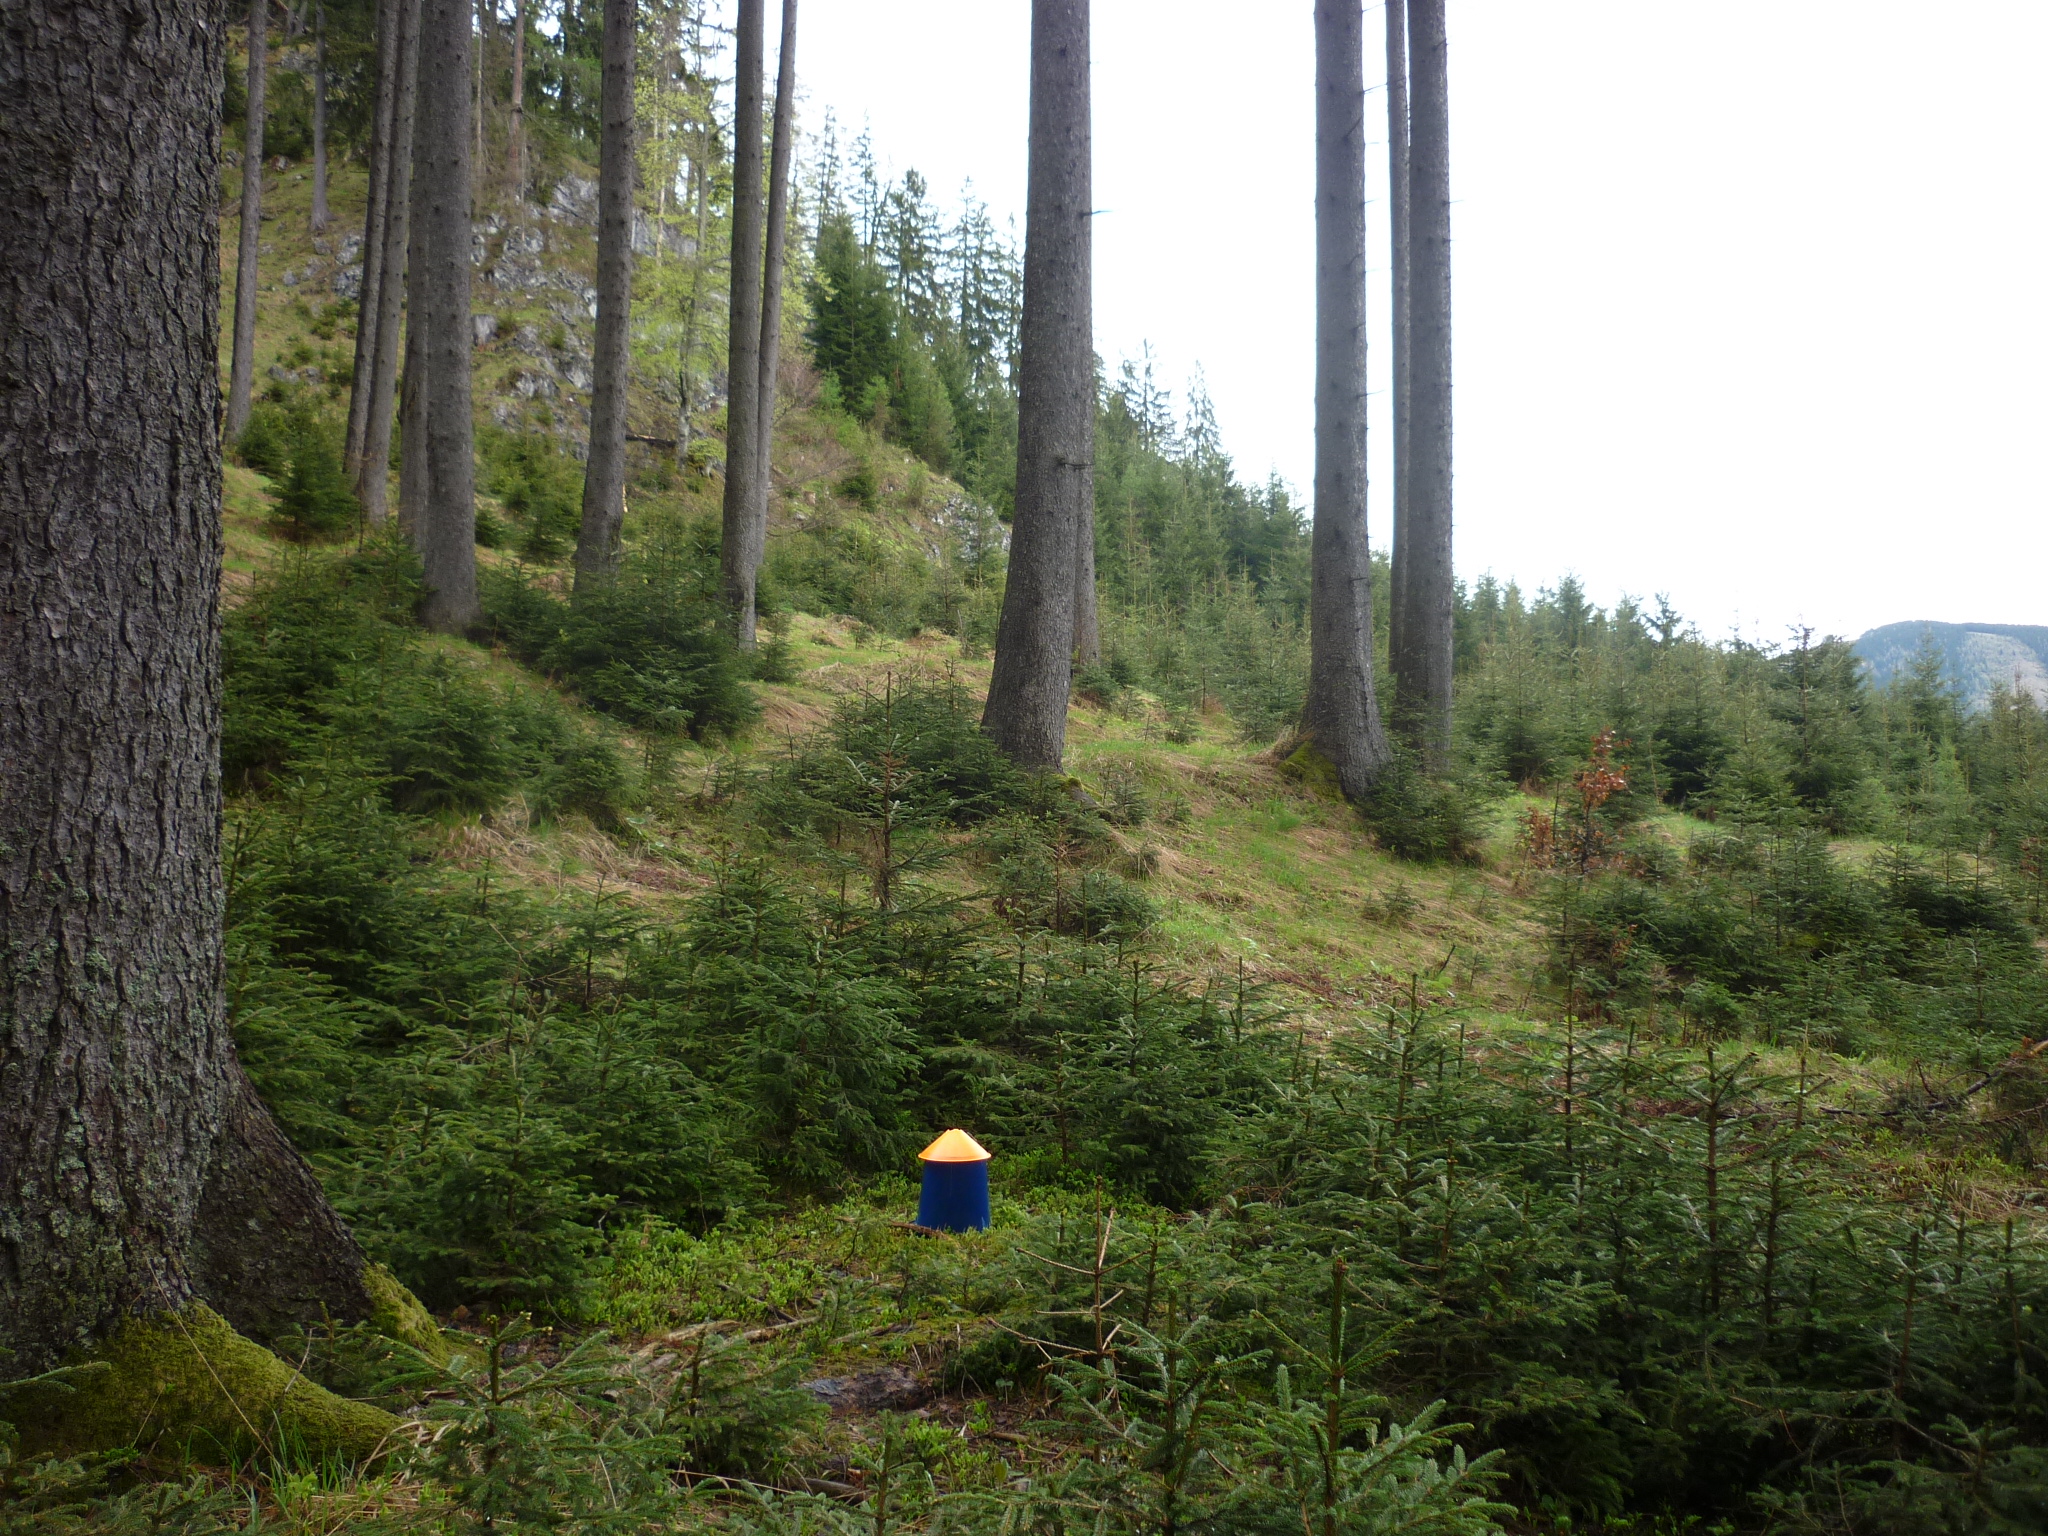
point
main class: Woodland
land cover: Spruce dominated coniferous woodland
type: alpine coniferous forest
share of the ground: 50 - 75 %
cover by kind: coniferous forest trees 70 %, herbaceous plants 20 %, lichens and mosses 10 %
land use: Forestry
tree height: > 5 m
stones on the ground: < 10 %
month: May
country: AT
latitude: 47.6424
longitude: 14.5652
